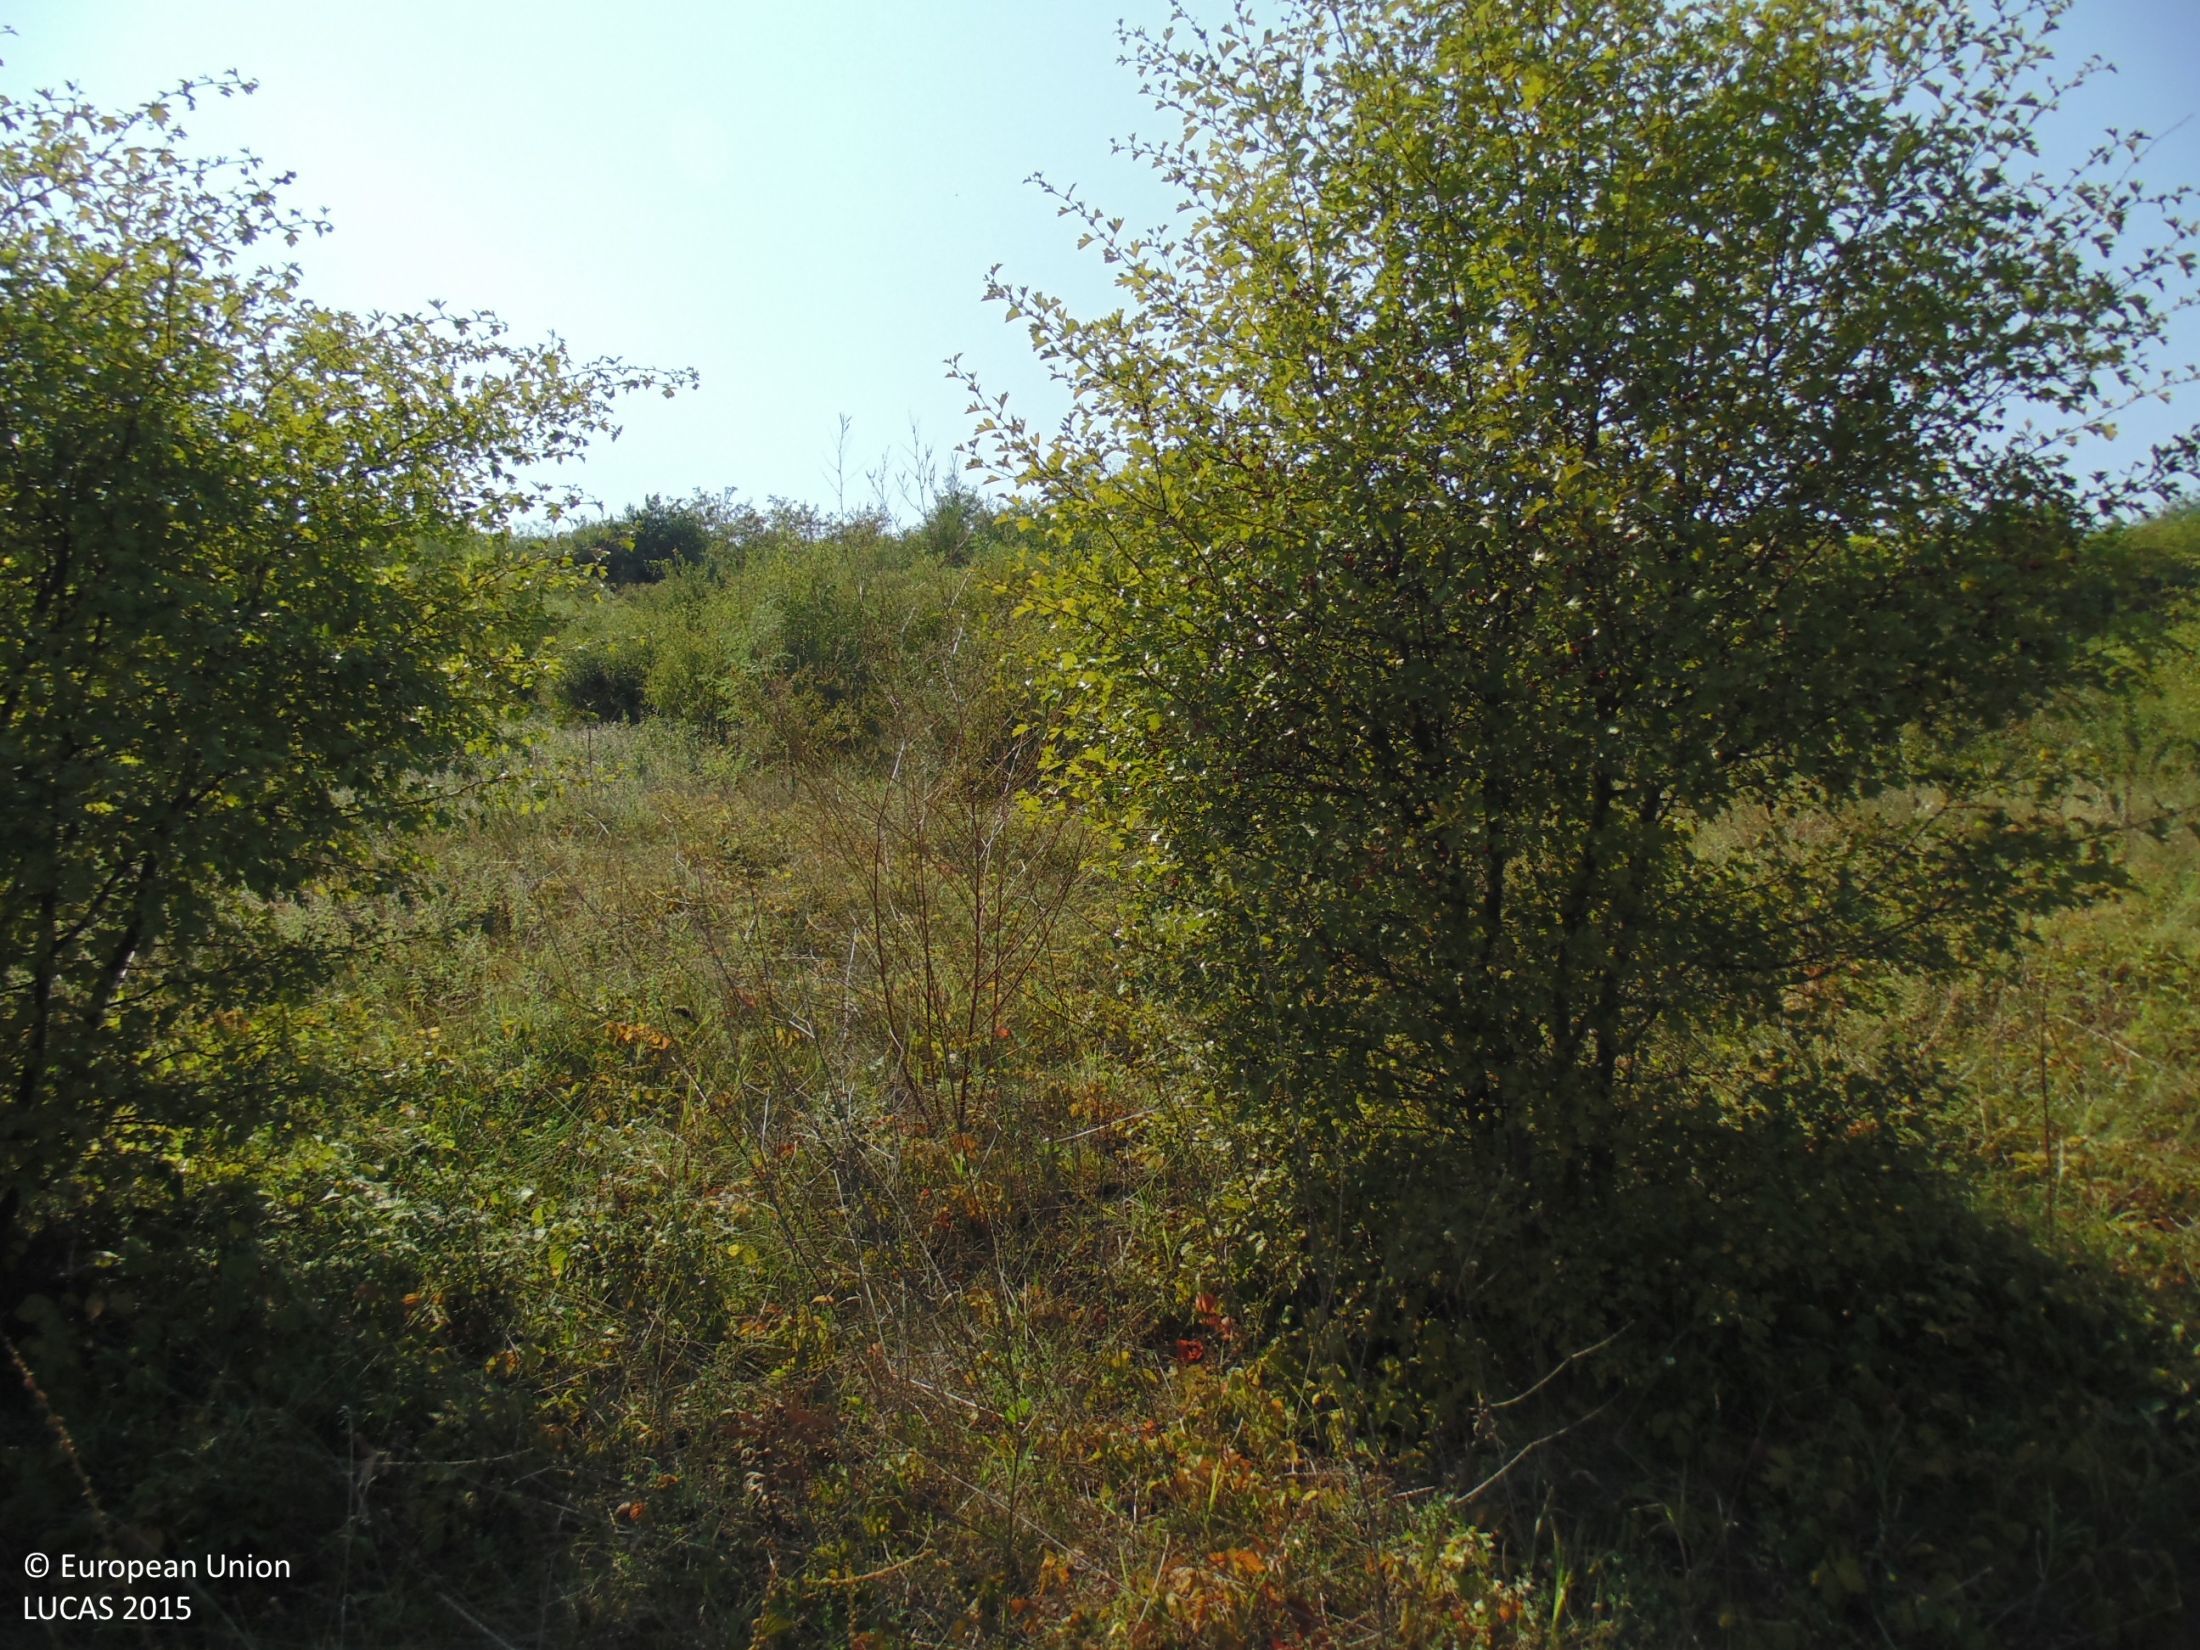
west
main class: Grassland
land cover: Grassland with sparse tree/shrub cover
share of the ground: > 75 %
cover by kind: herbaceous plants 90 %, broadleaved forest trees 5 %, shrubs 5 %
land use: Abandoned areas
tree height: < 5 m
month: August
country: BG
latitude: 43.9588
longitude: 27.3682
